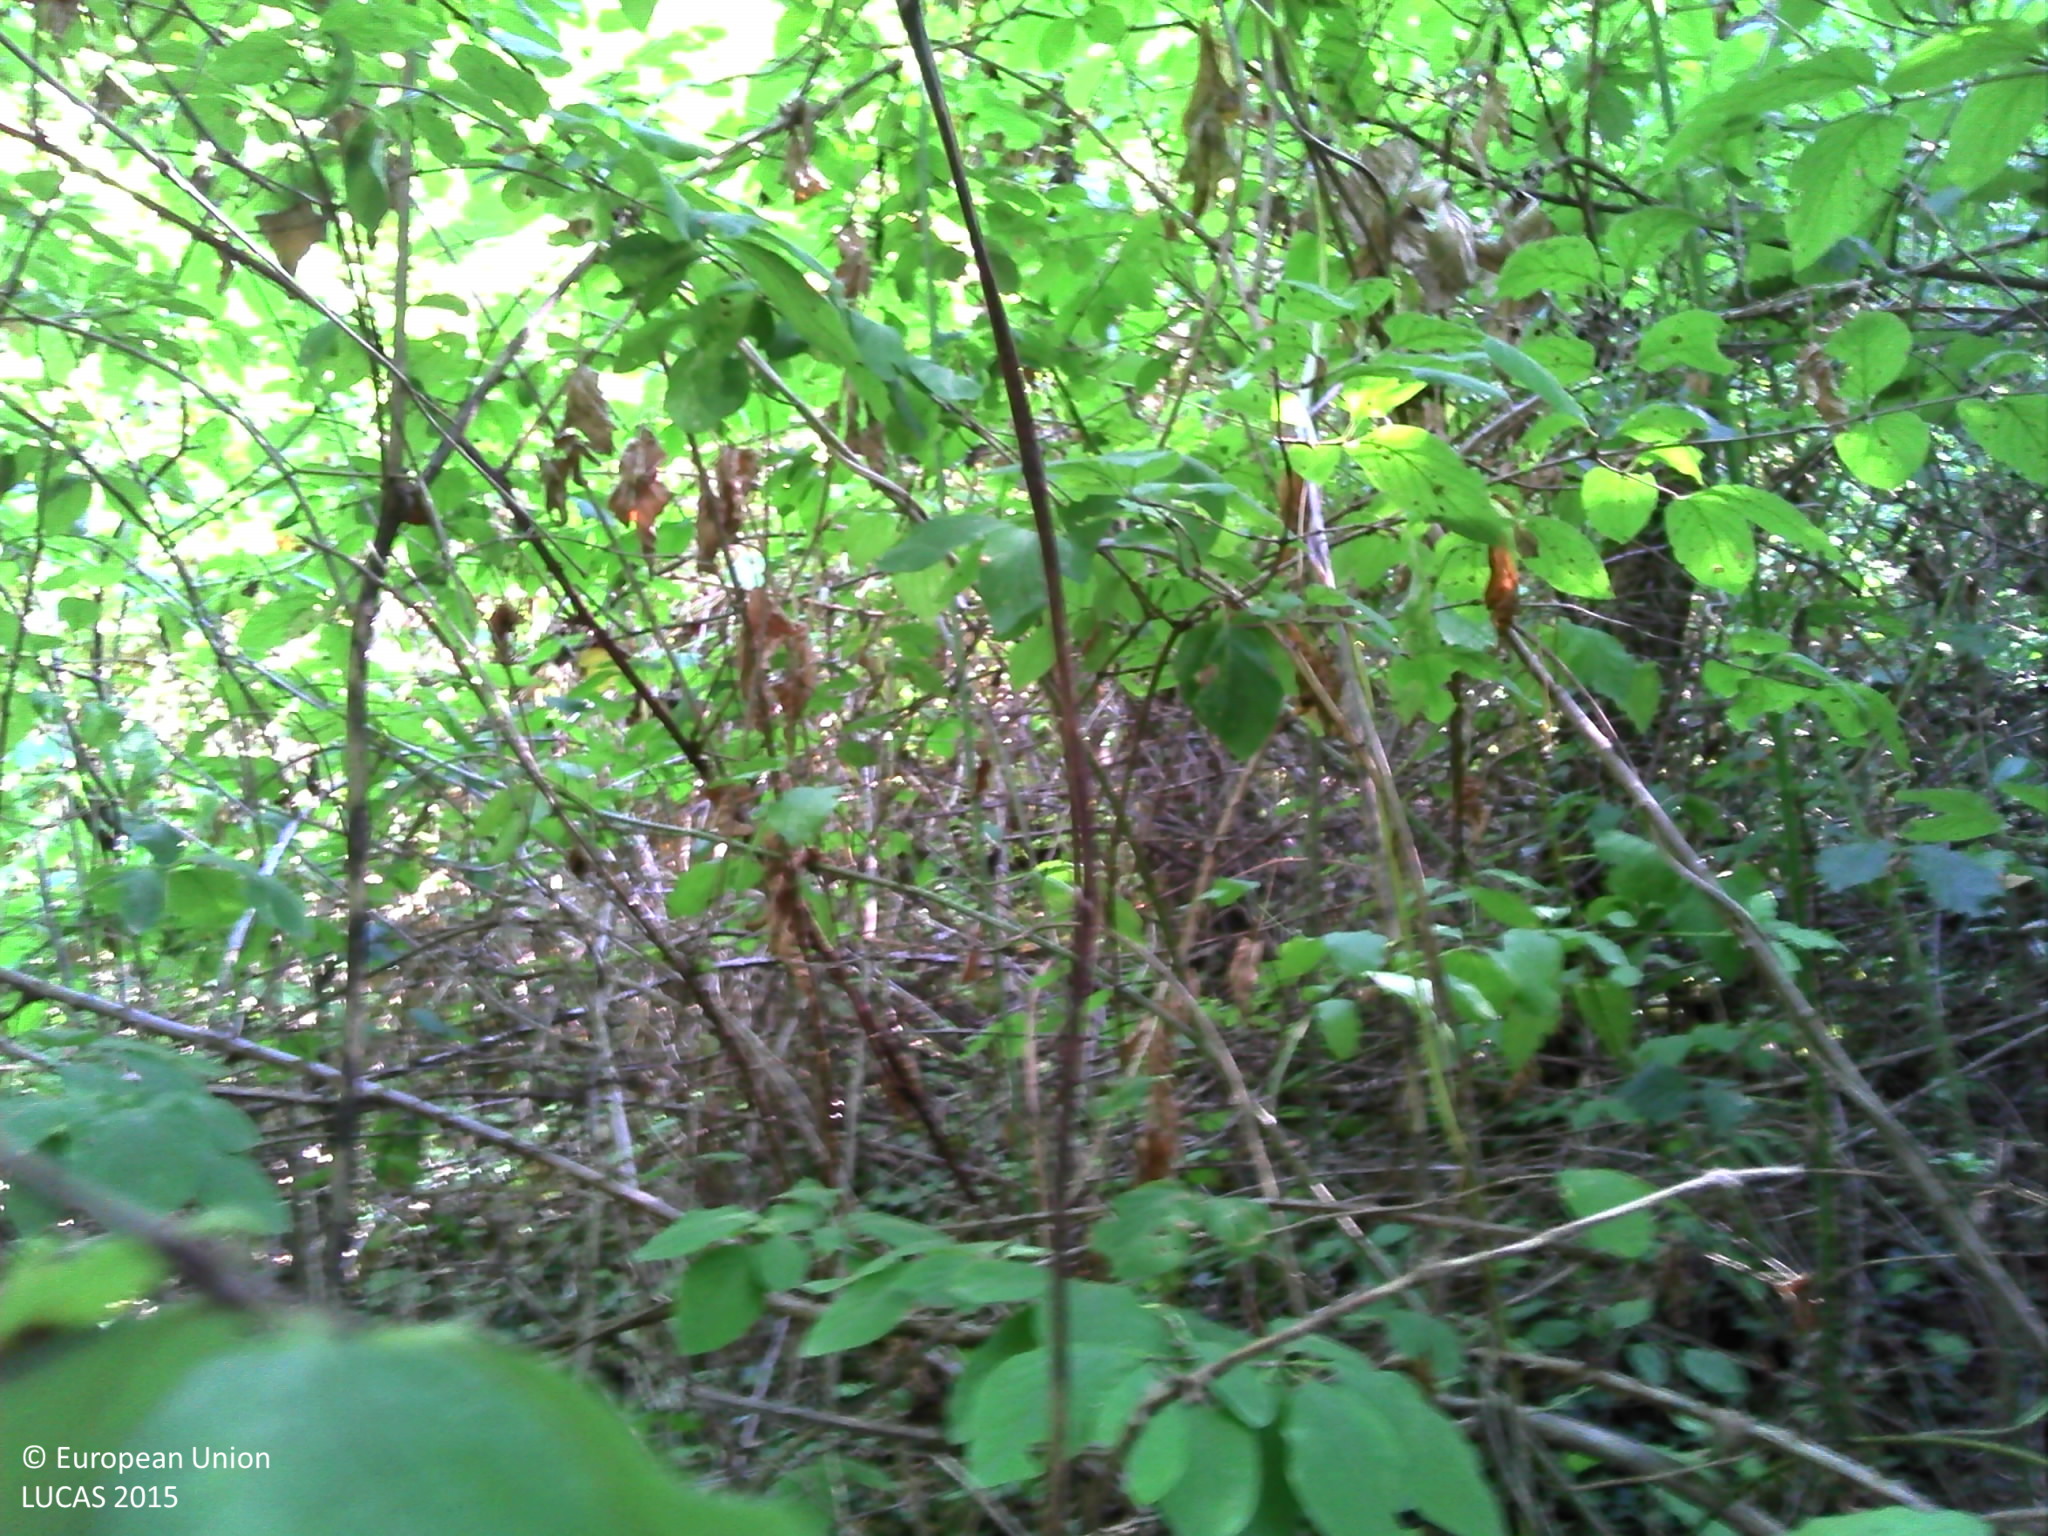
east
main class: Woodland
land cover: Pine dominated mixed woodland
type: hemiboreal forest and nemoral coniferous forest and mixed broadleaved-coniferous forest
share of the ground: > 75 %
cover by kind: coniferous forest trees 60 %, broadleaved forest trees 30 %, herbaceous plants 5 %, lichens and mosses 5 %
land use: Forestry
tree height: > 5 m
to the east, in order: Pine dominated mixed woodland; Tracks; Broadleaved woodland; Tracks; Broadleaved woodland; Grassland without tree/shrub cover; Common wheat
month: August
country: FR
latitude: 47.8667
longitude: 3.4580
